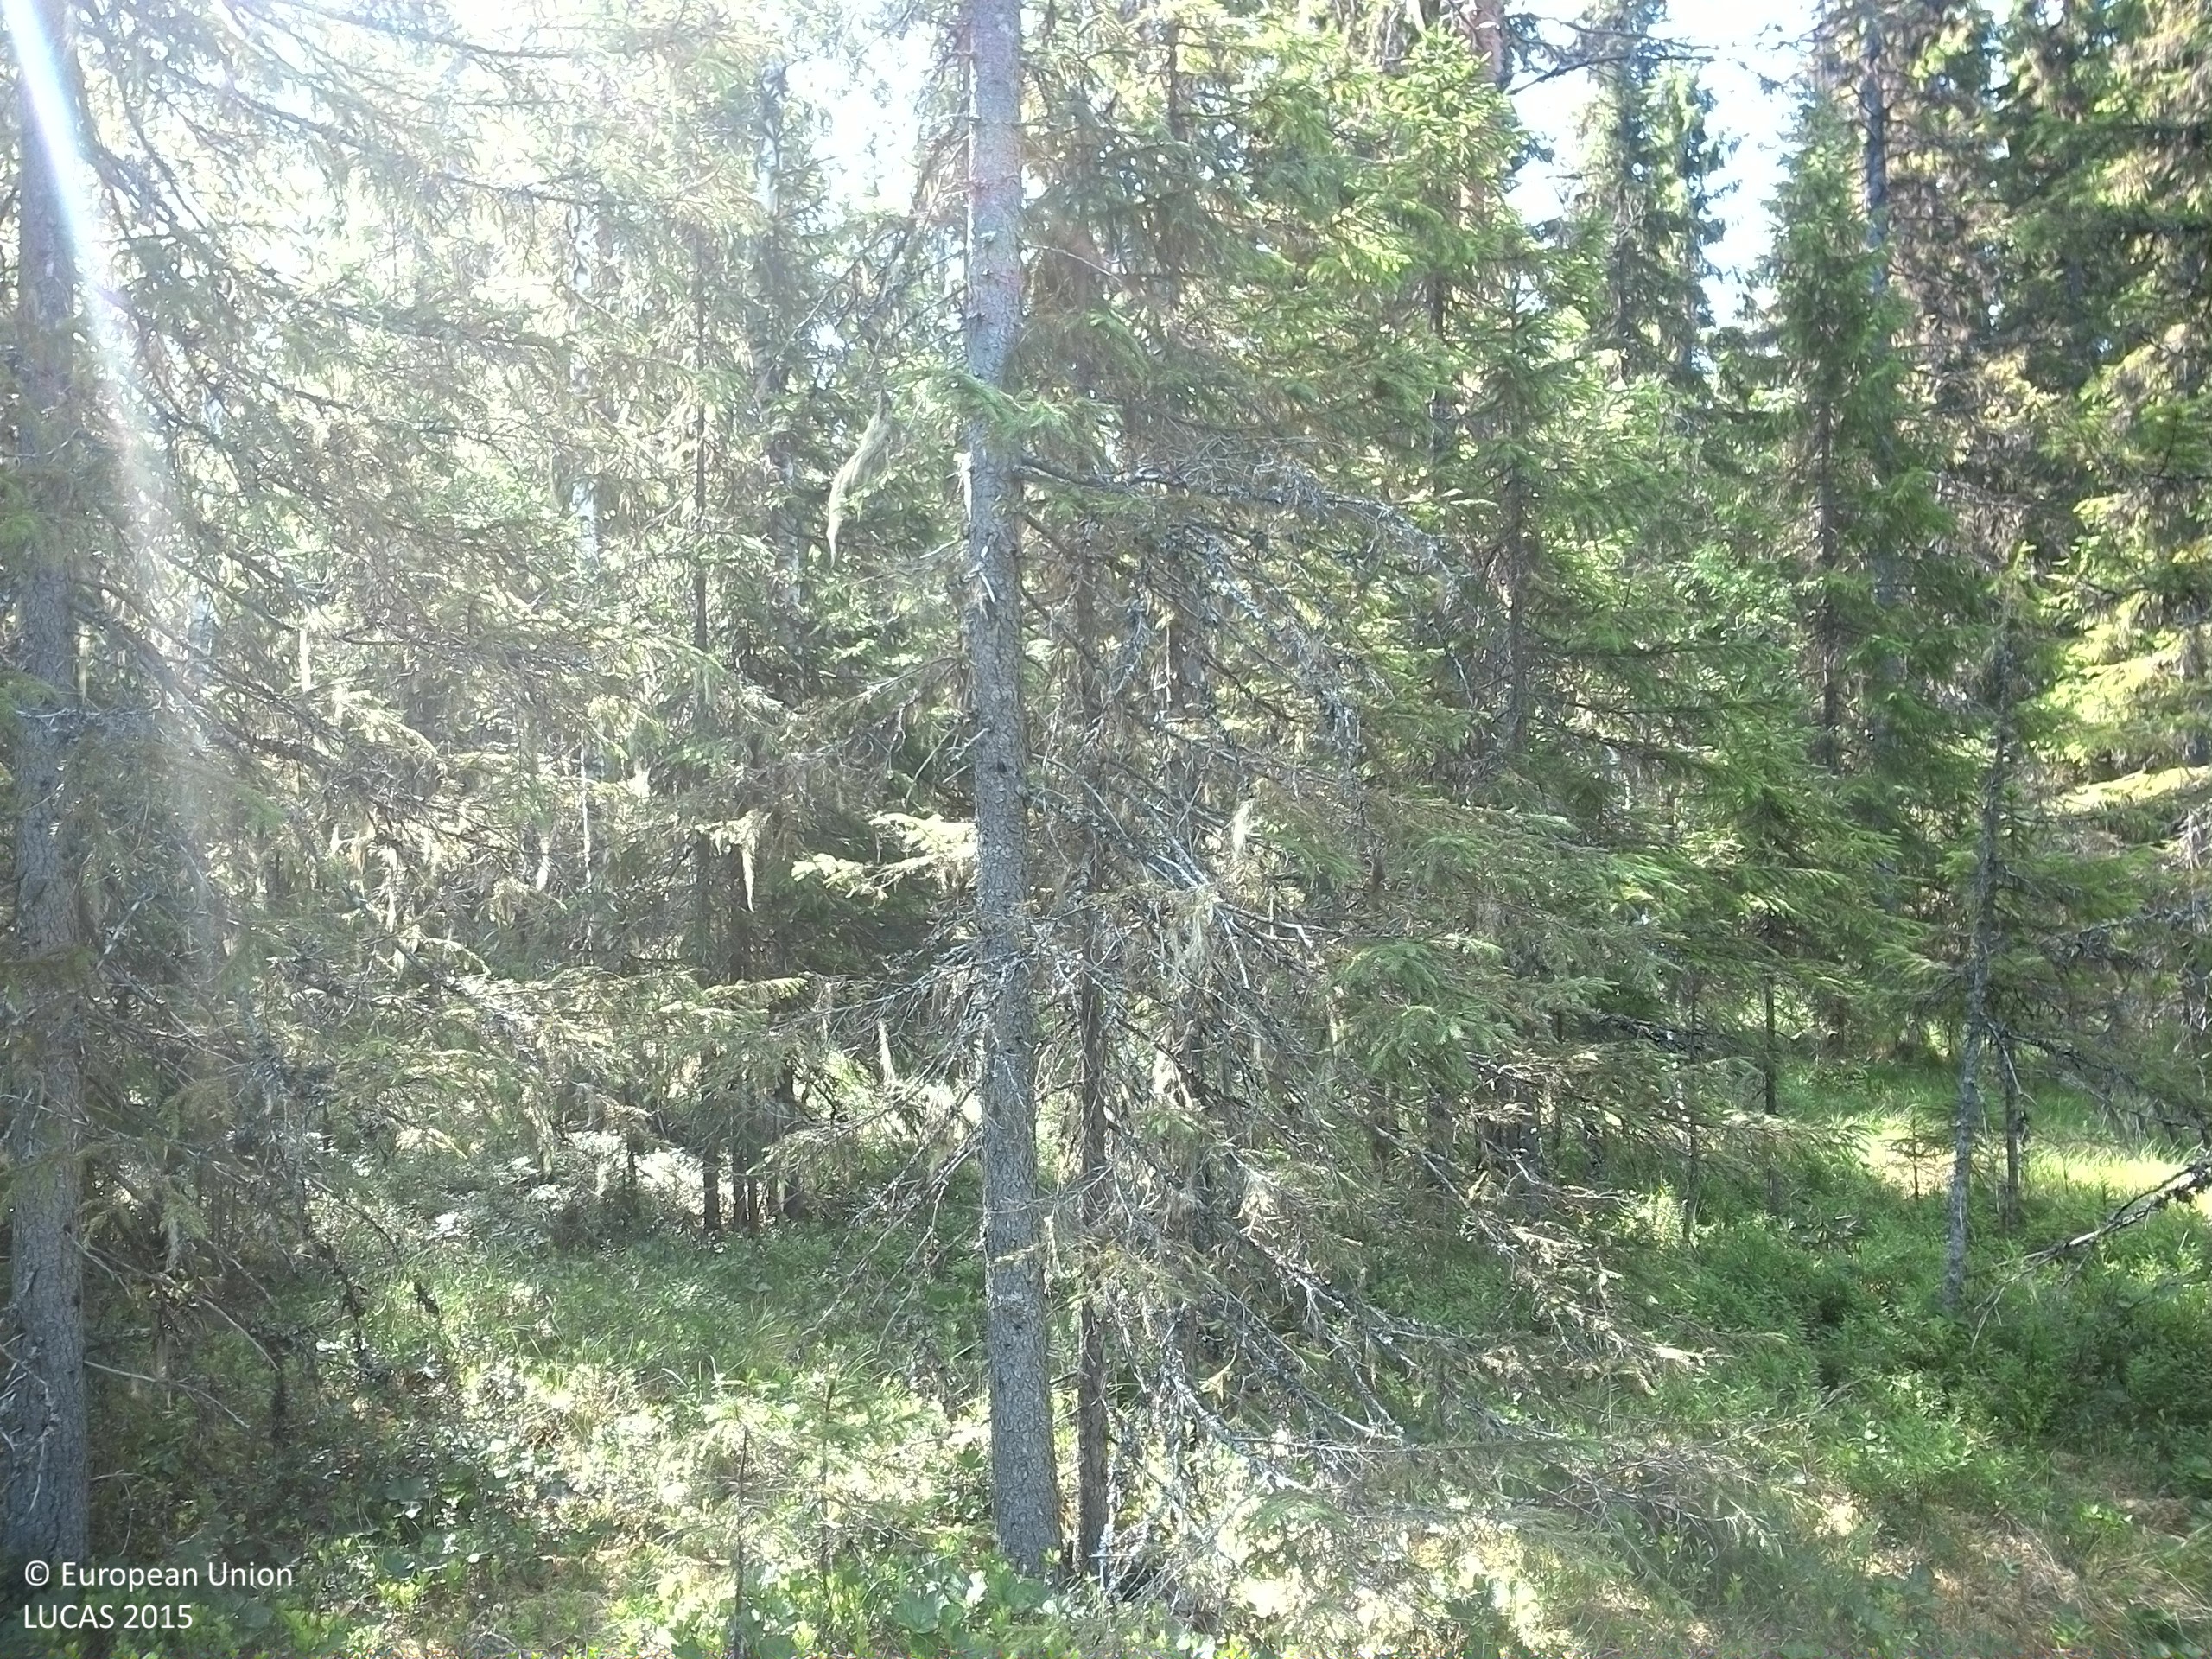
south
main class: Woodland
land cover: Spruce dominated coniferous woodland
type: boreal forest
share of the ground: 25 - 50 %
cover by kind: coniferous forest trees 35 %, lichens and mosses 30 %, shrubs 20 %, broadleaved forest trees 10 %, herbaceous plants 5 %
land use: Forestry
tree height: > 5 m
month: July
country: SE
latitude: 63.4989
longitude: 17.7882
